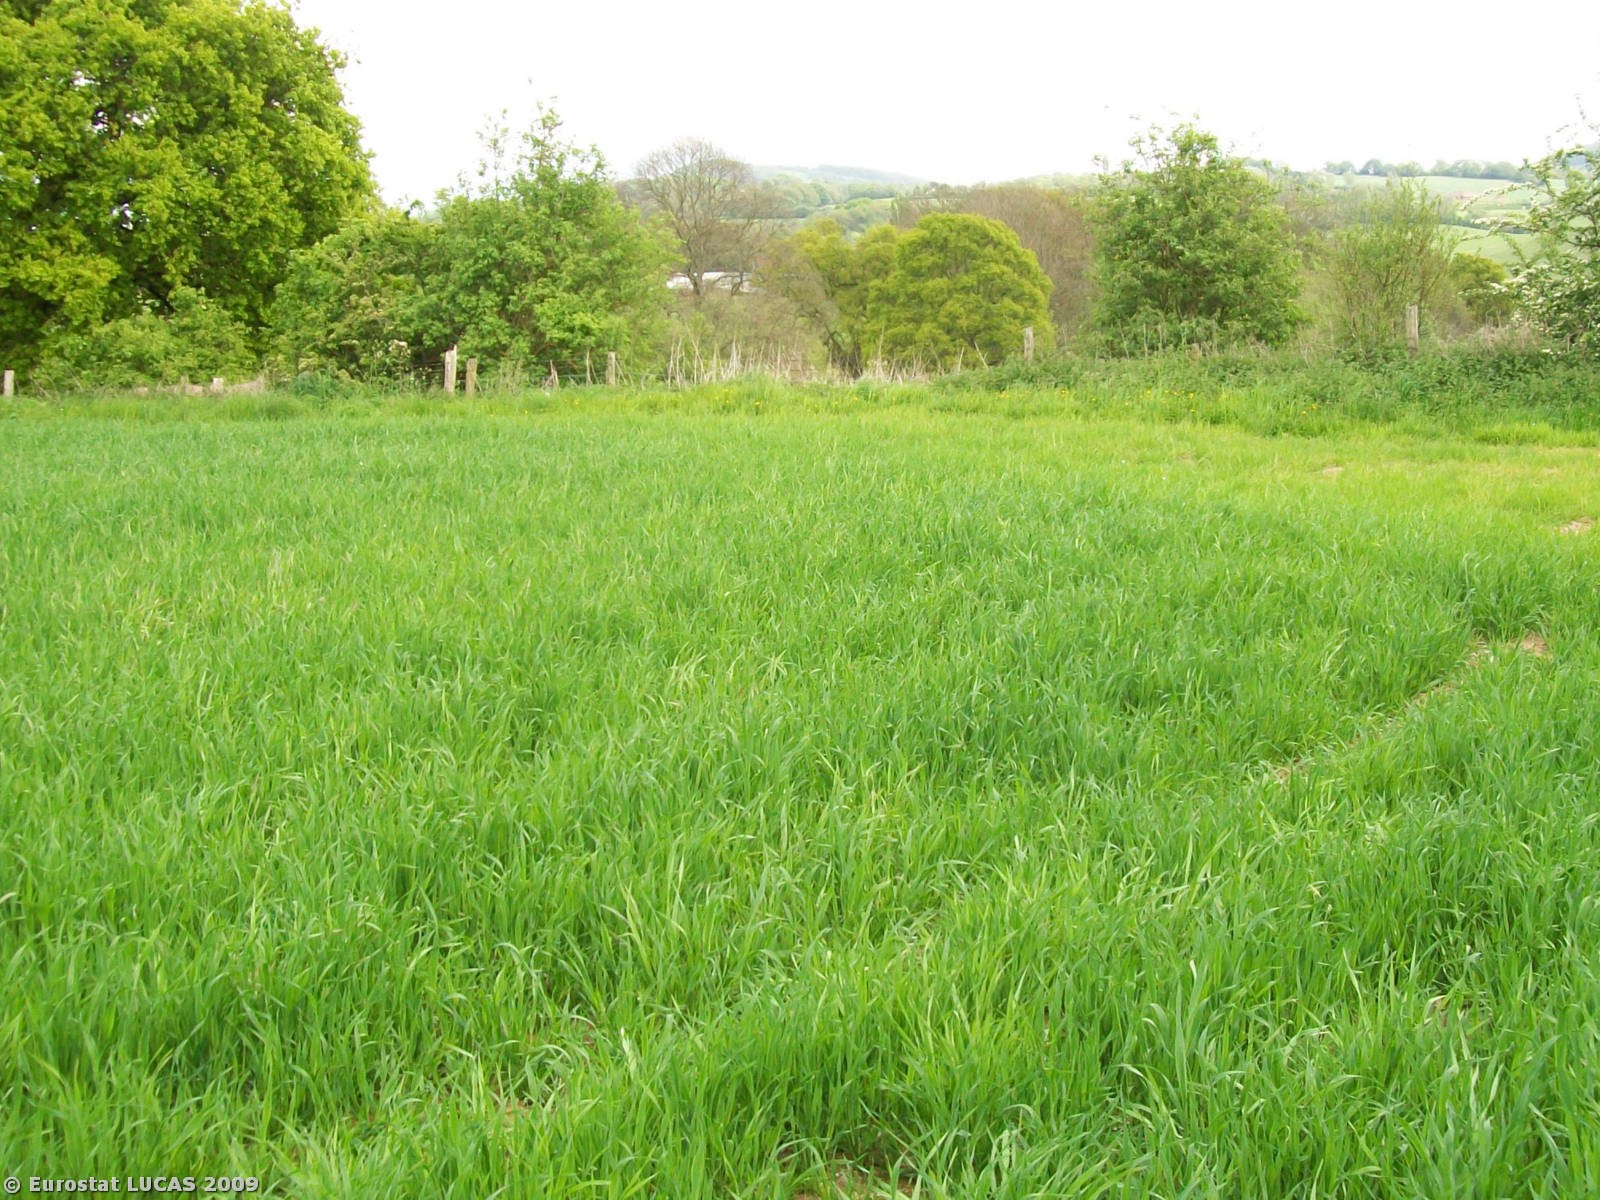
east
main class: Cropland
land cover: Oats
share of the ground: > 75 %
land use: Agriculture (excluding fallow land and kitchen gardens)
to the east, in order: Oats; Fences; Abandoned hedges; Grassland without tree/shrub cover; Fences; Abandoned hedges; Rivers and streams; Spontaneously vegetated surfaces; Barley; Grass margins; Managed hedges; Ditches and canals; Fences; Grassland without tree/shrub cover
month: May
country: GB
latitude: 52.3036
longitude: -2.4281
